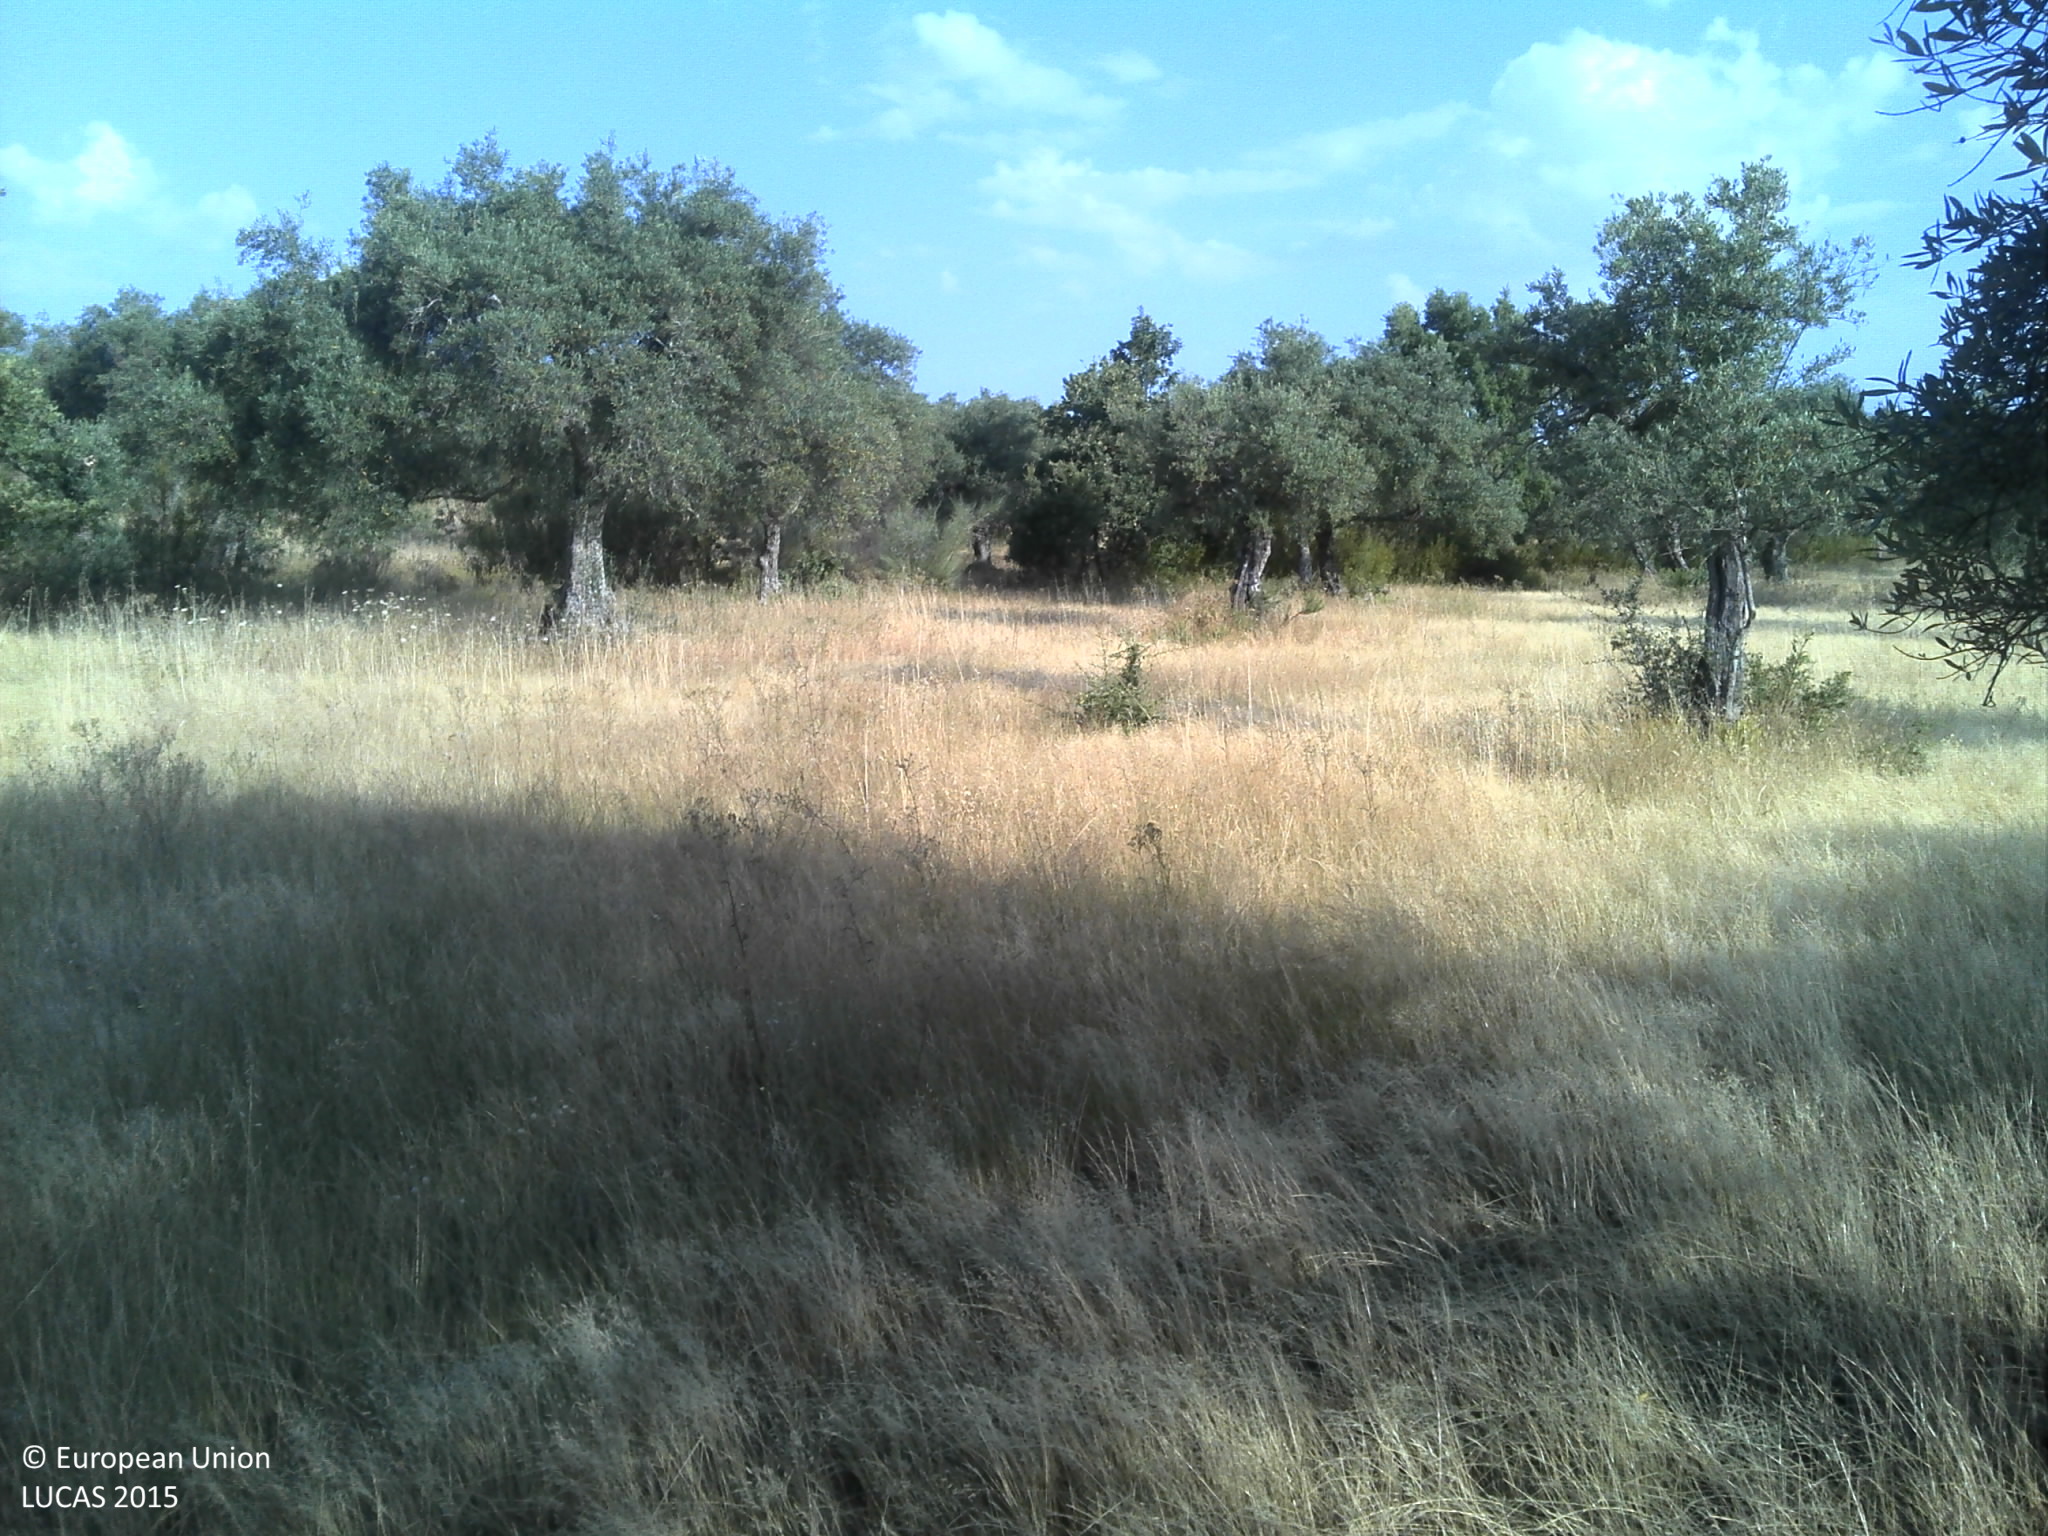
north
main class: Cropland
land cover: Olive groves
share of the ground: 25 - 50 %
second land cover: Spontaneously vegetated surfaces
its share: 25 - 50 %
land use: Agriculture (excluding fallow land and kitchen gardens)
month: June
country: PT
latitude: 40.0971
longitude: -7.1149
